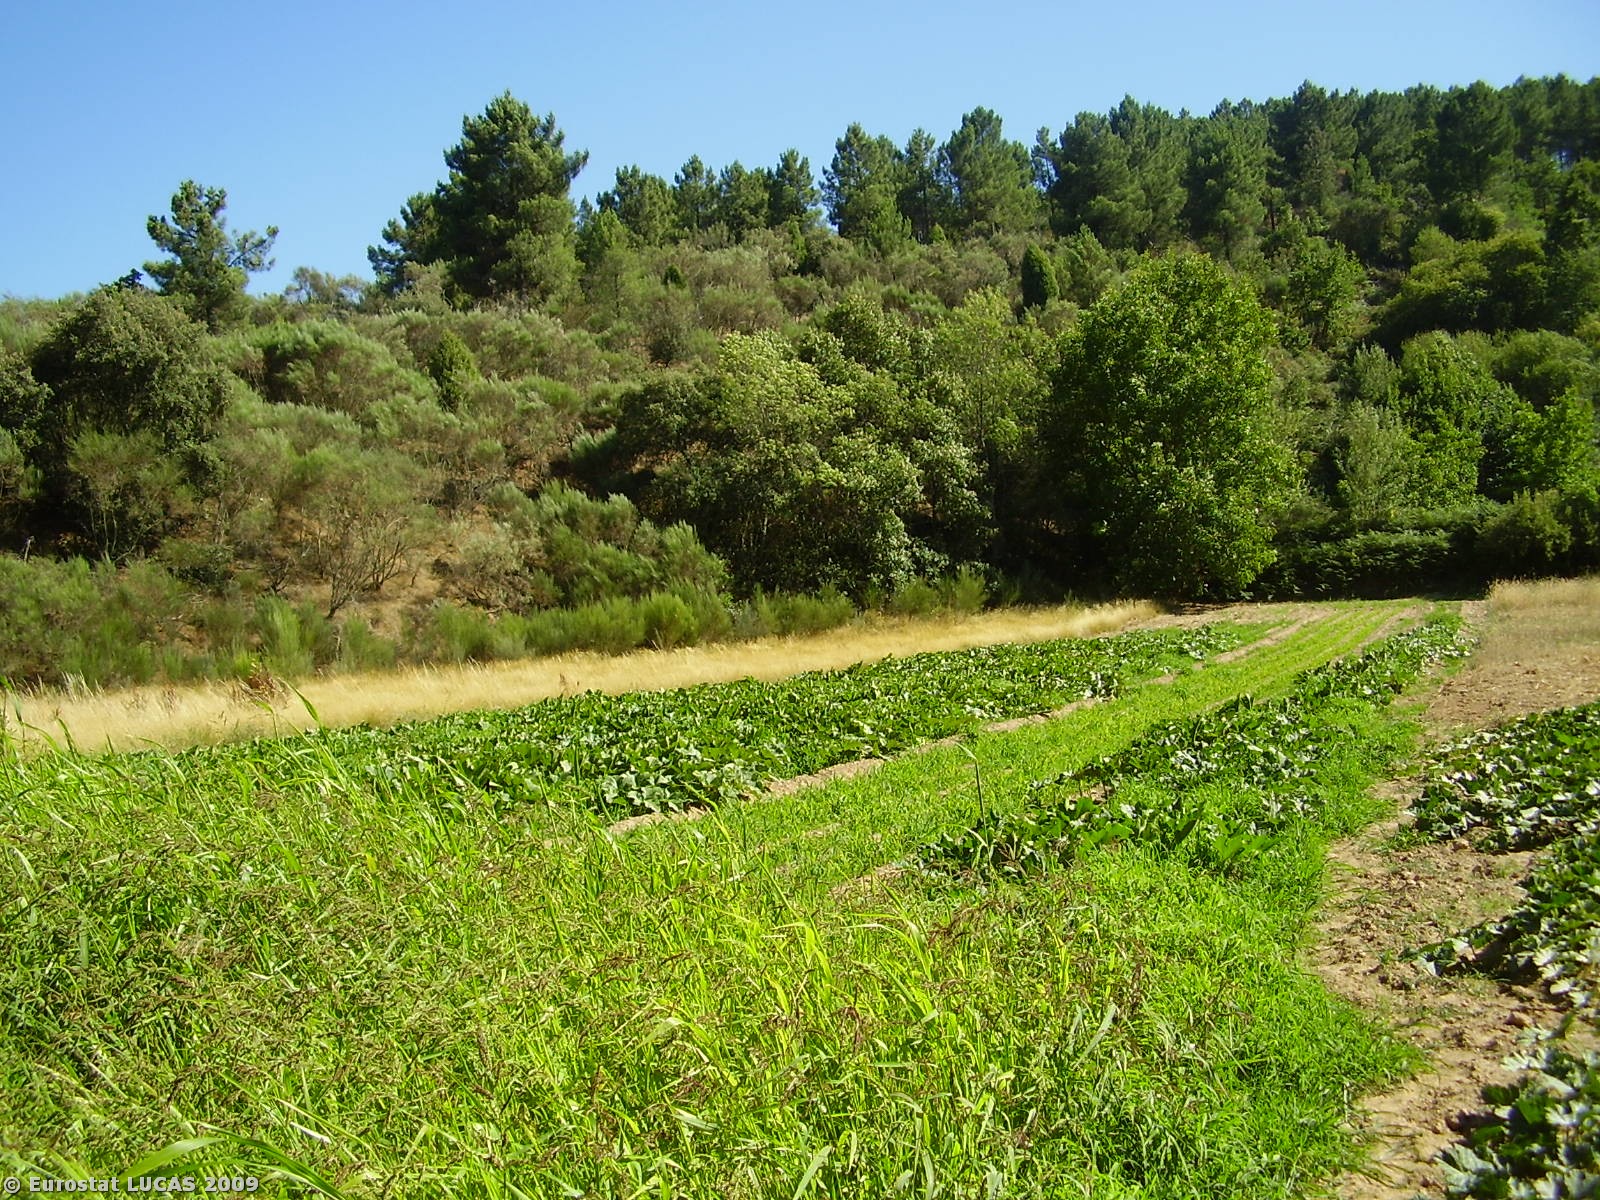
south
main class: Cropland
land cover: Mixed cereals for fodder
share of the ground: > 75 %
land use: Agriculture (excluding fallow land and kitchen gardens)
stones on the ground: < 10 %
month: July
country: PT
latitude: 41.6361
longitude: -7.3768
